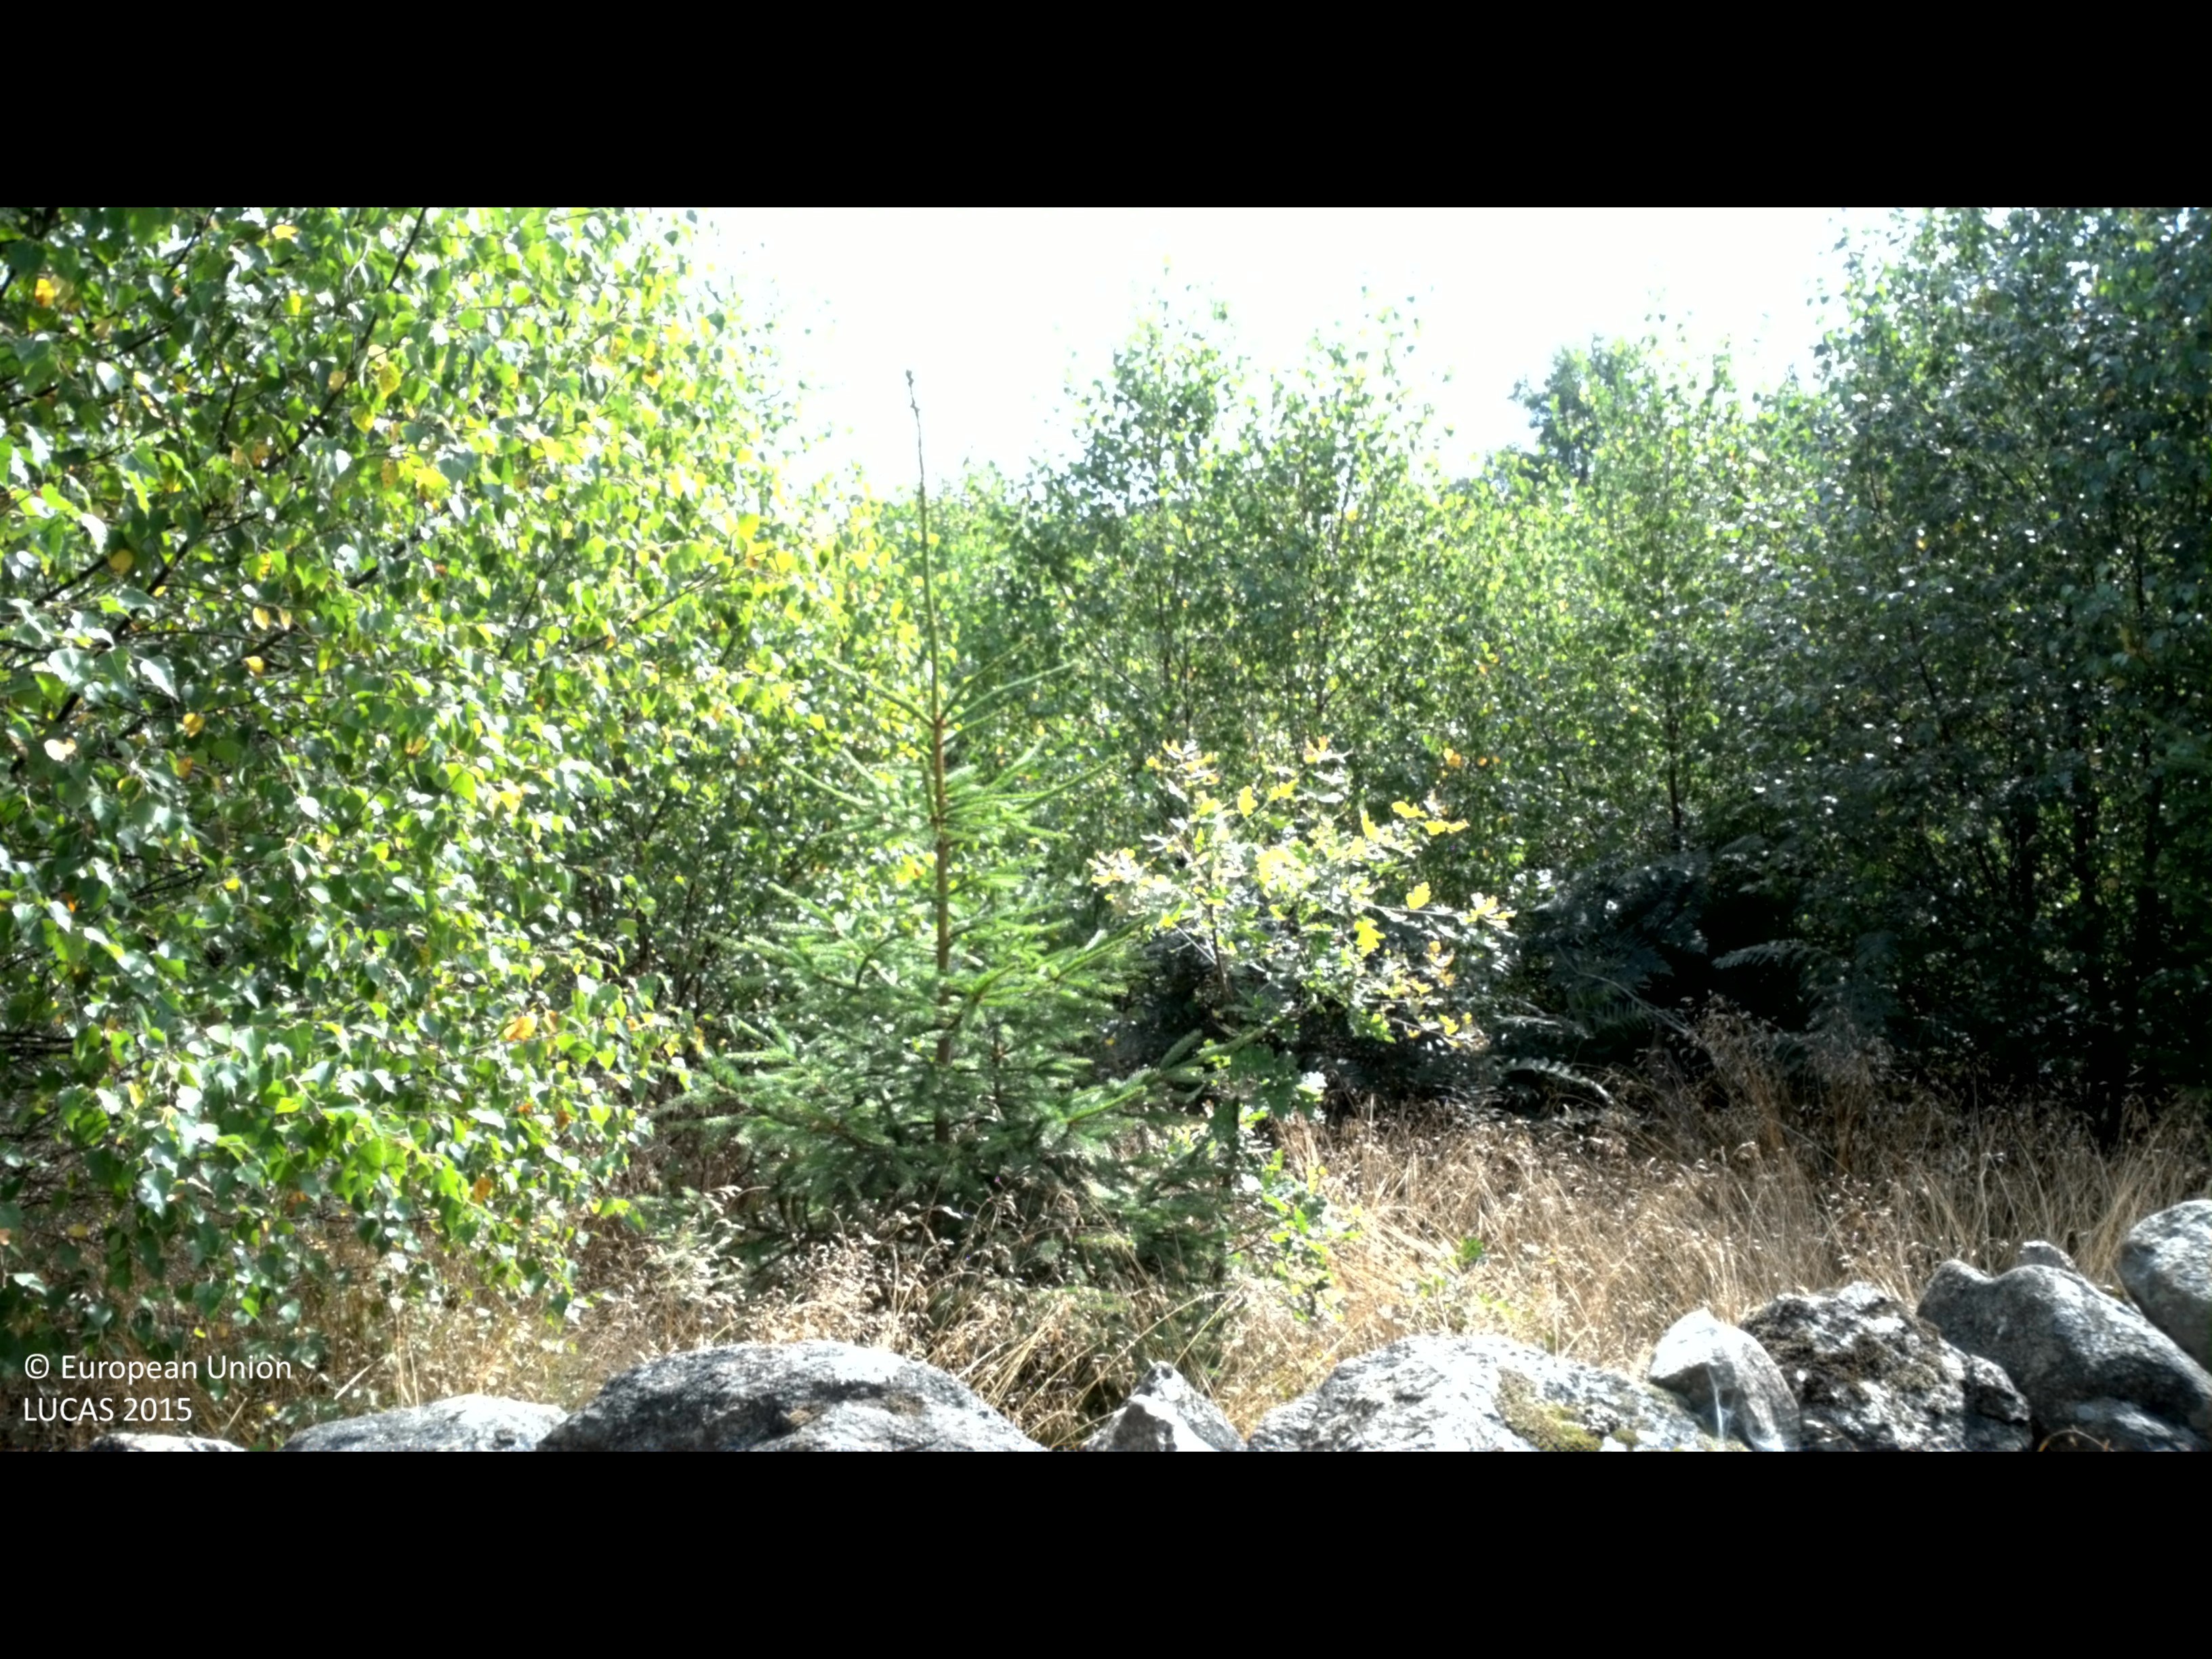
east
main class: Woodland
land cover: Broadleaved woodland
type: boreal forest
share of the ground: 50 - 75 %
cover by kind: broadleaved forest trees 65 %, herbaceous plants 25 %, coniferous forest trees 5 %, shrubs 5 %
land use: Forestry
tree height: < 5 m
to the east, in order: Broadleaved woodland; Dry stone walls; Broadleaved woodland; Dry stone walls; Electric lines; Paved roads, cycling and walking lanes; Grass margins; Broadleaved woodland; Dry stone walls; Electric lines; Broadleaved woodland; Dry stone walls; Fences; Broadleaved woodland
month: August
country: SE
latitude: 56.2702
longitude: 15.8620
